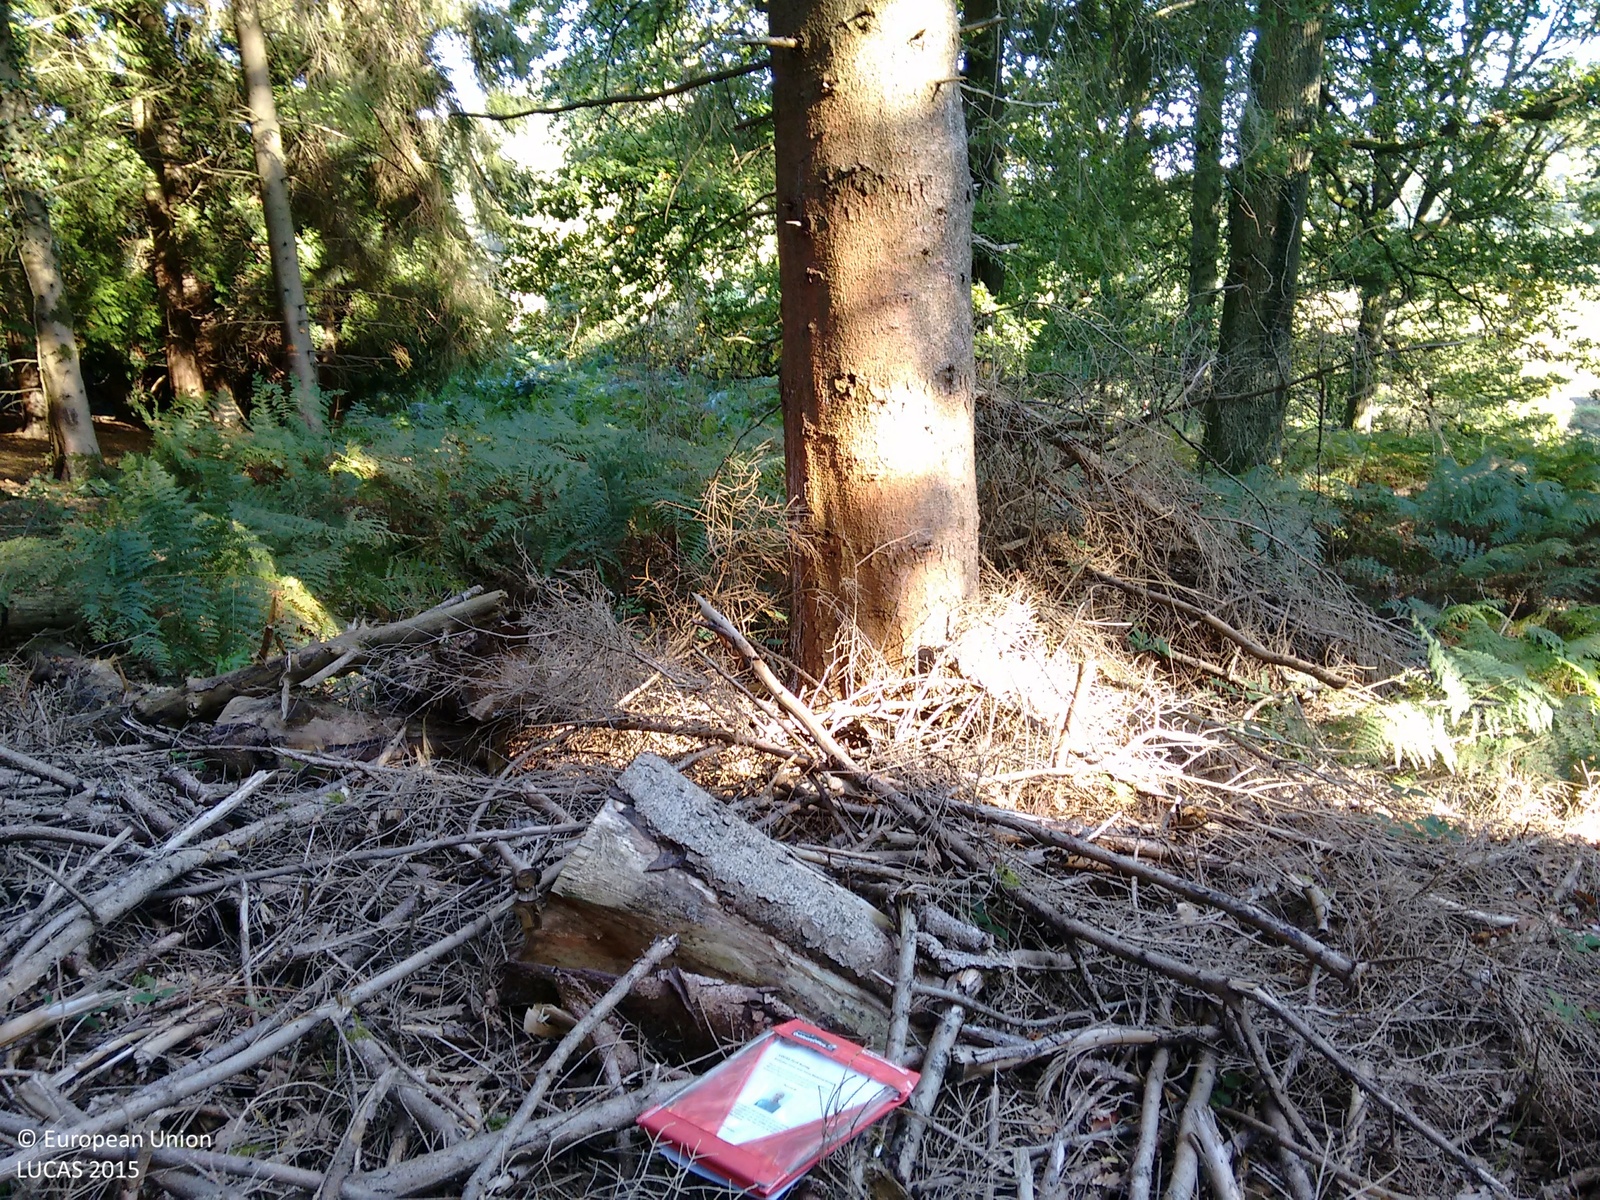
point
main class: Woodland
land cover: Spruce dominated coniferous woodland
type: exotic forest
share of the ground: > 75 %
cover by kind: coniferous forest trees 70 %, herbaceous plants 30 %
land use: Forestry
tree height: > 5 m
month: September
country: GB
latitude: 51.8373
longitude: -2.5338
